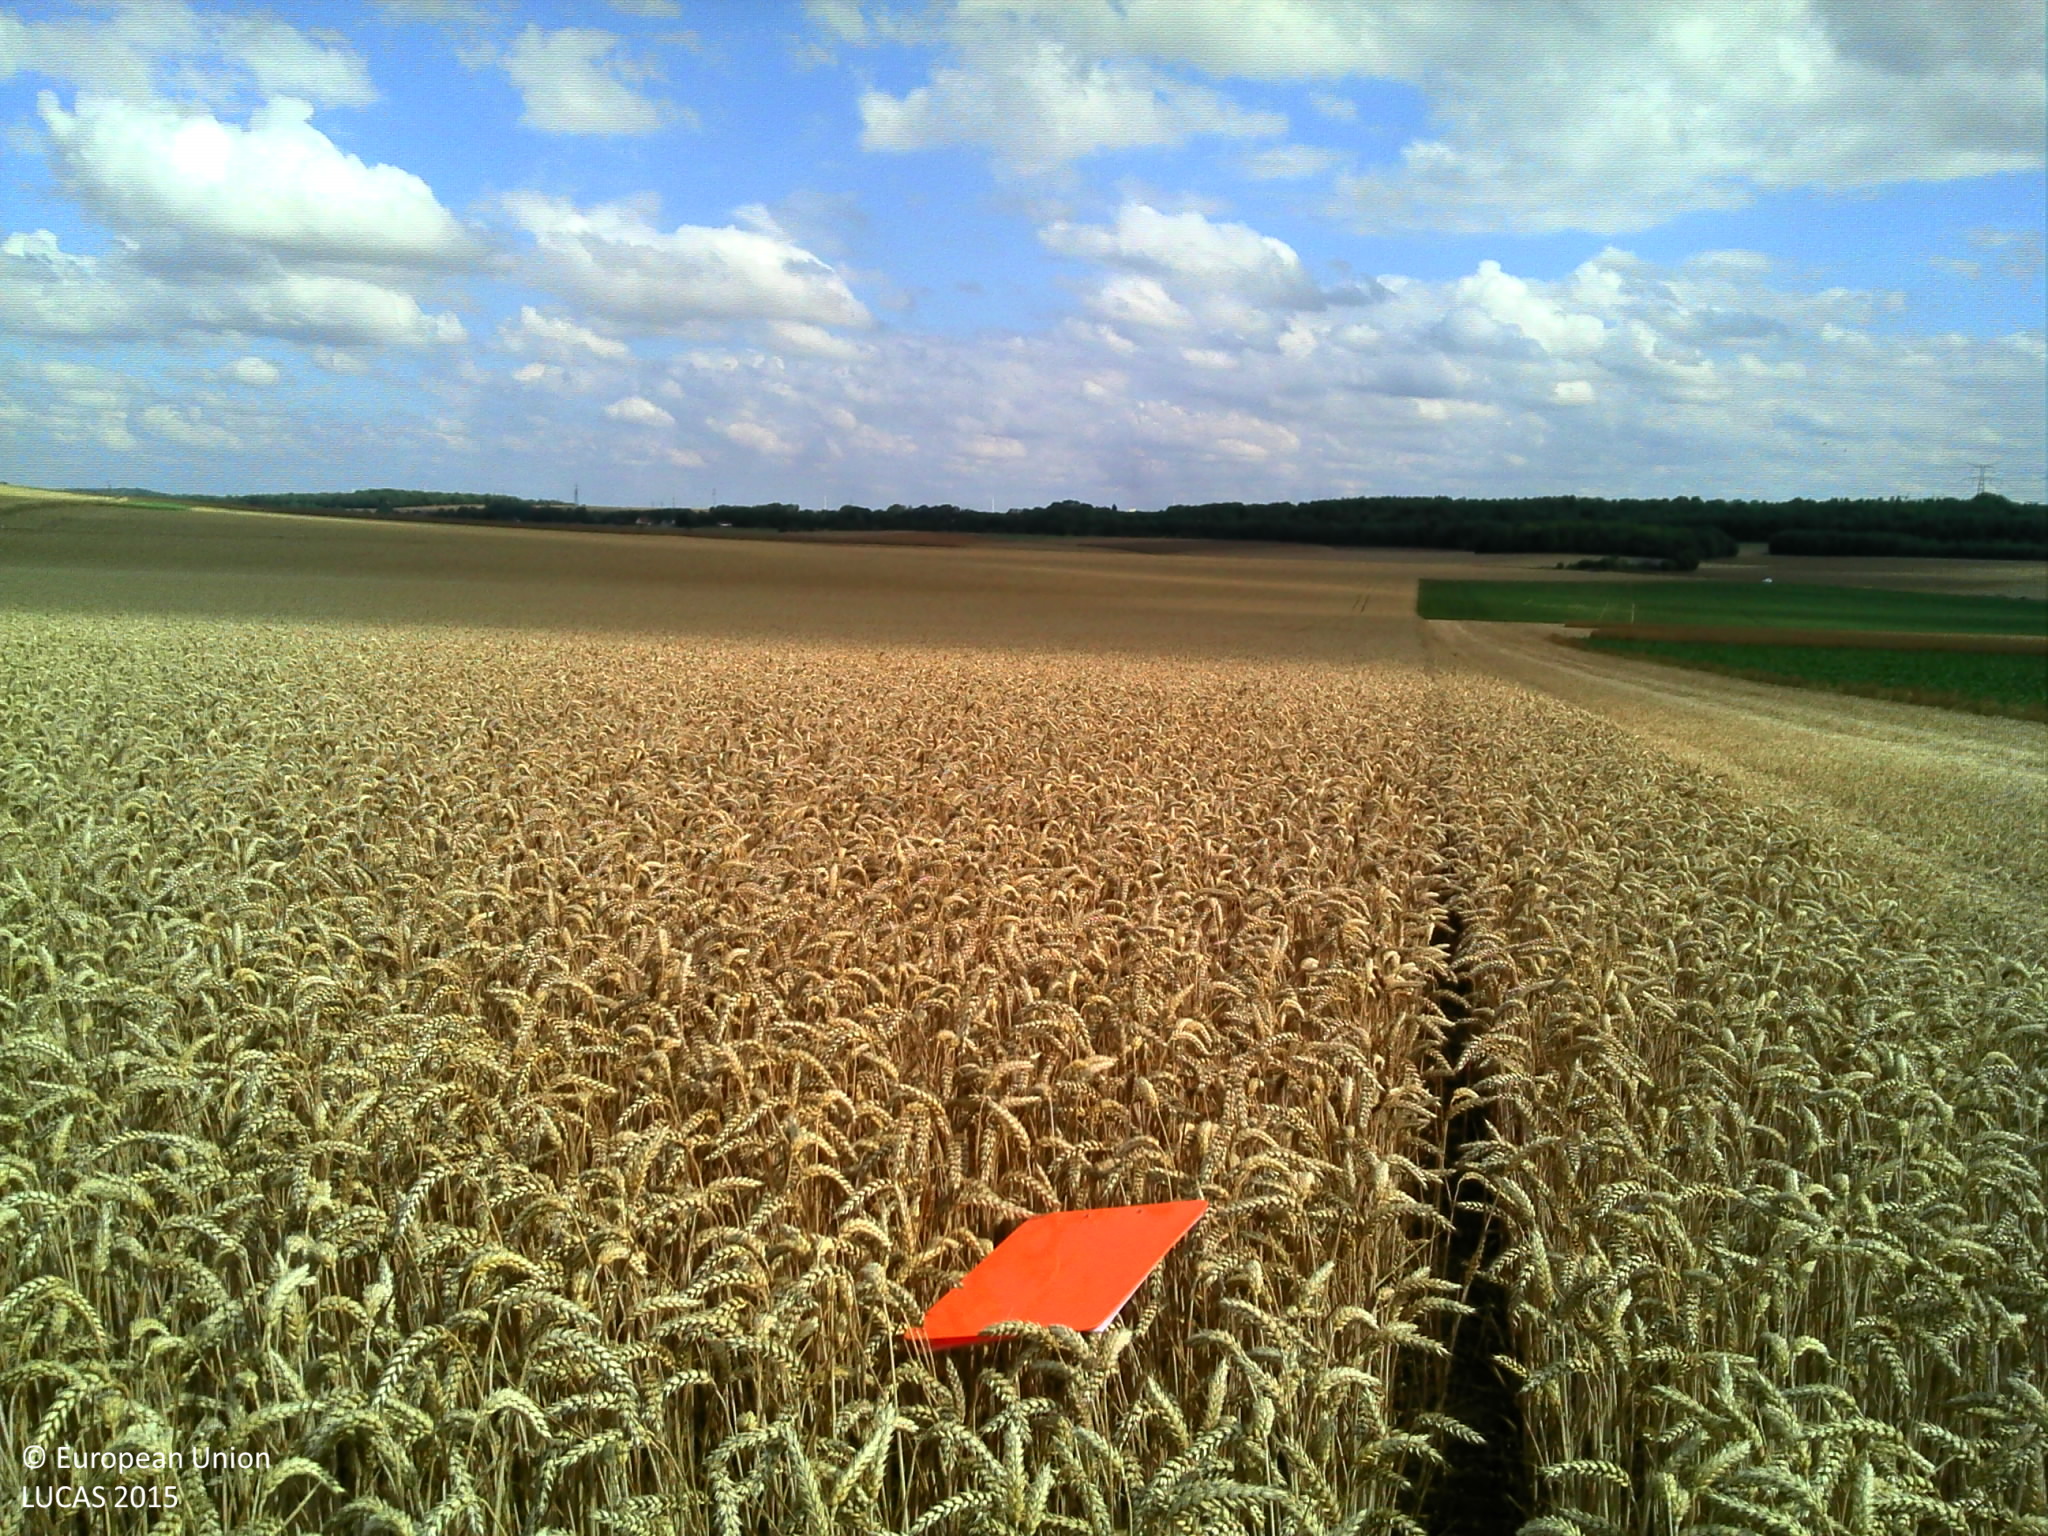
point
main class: Cropland
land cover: Common wheat
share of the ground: > 75 %
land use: Agriculture (excluding fallow land and kitchen gardens)
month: July
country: FR
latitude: 49.9724
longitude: 2.2197
